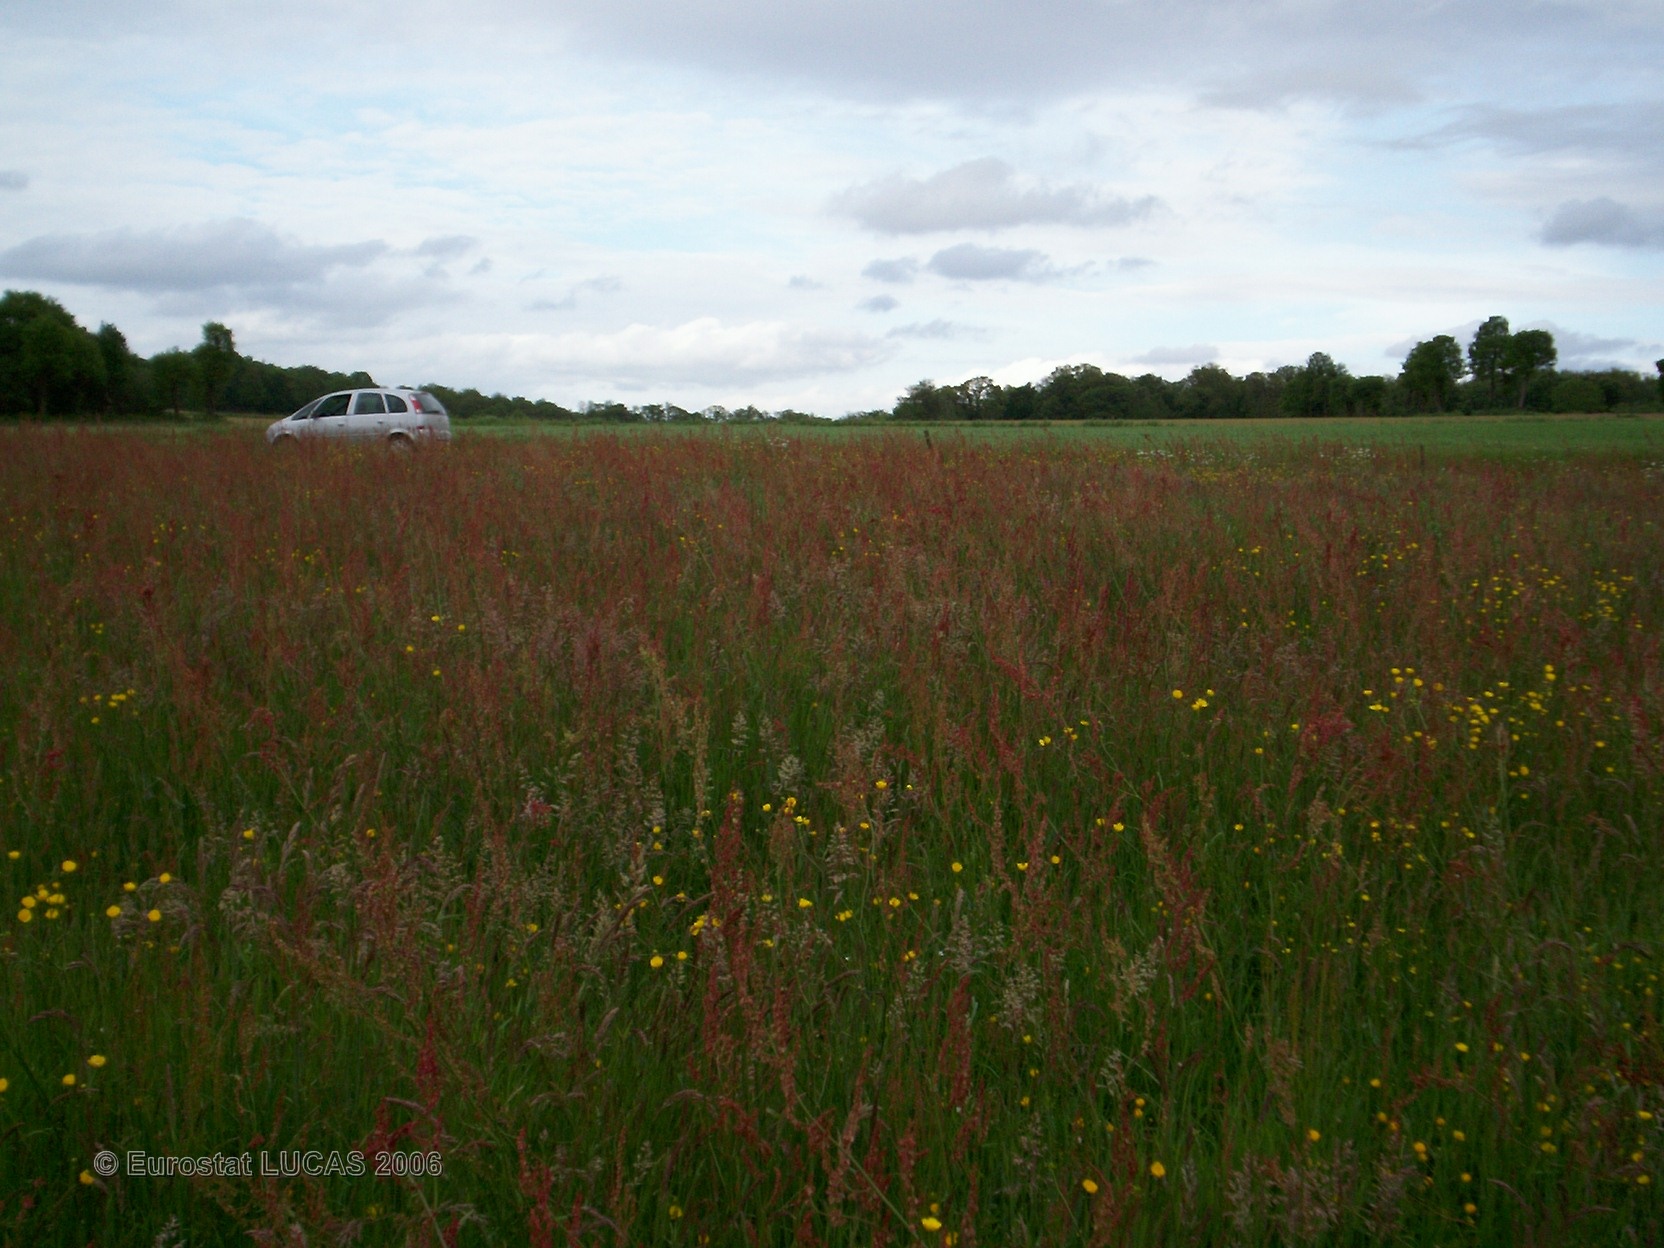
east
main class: Grassland
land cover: Grassland without tree/shrub cover
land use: Agriculture (excluding fallow land and kitchen gardens)
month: May
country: FR
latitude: 48.3243
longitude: -2.3728
